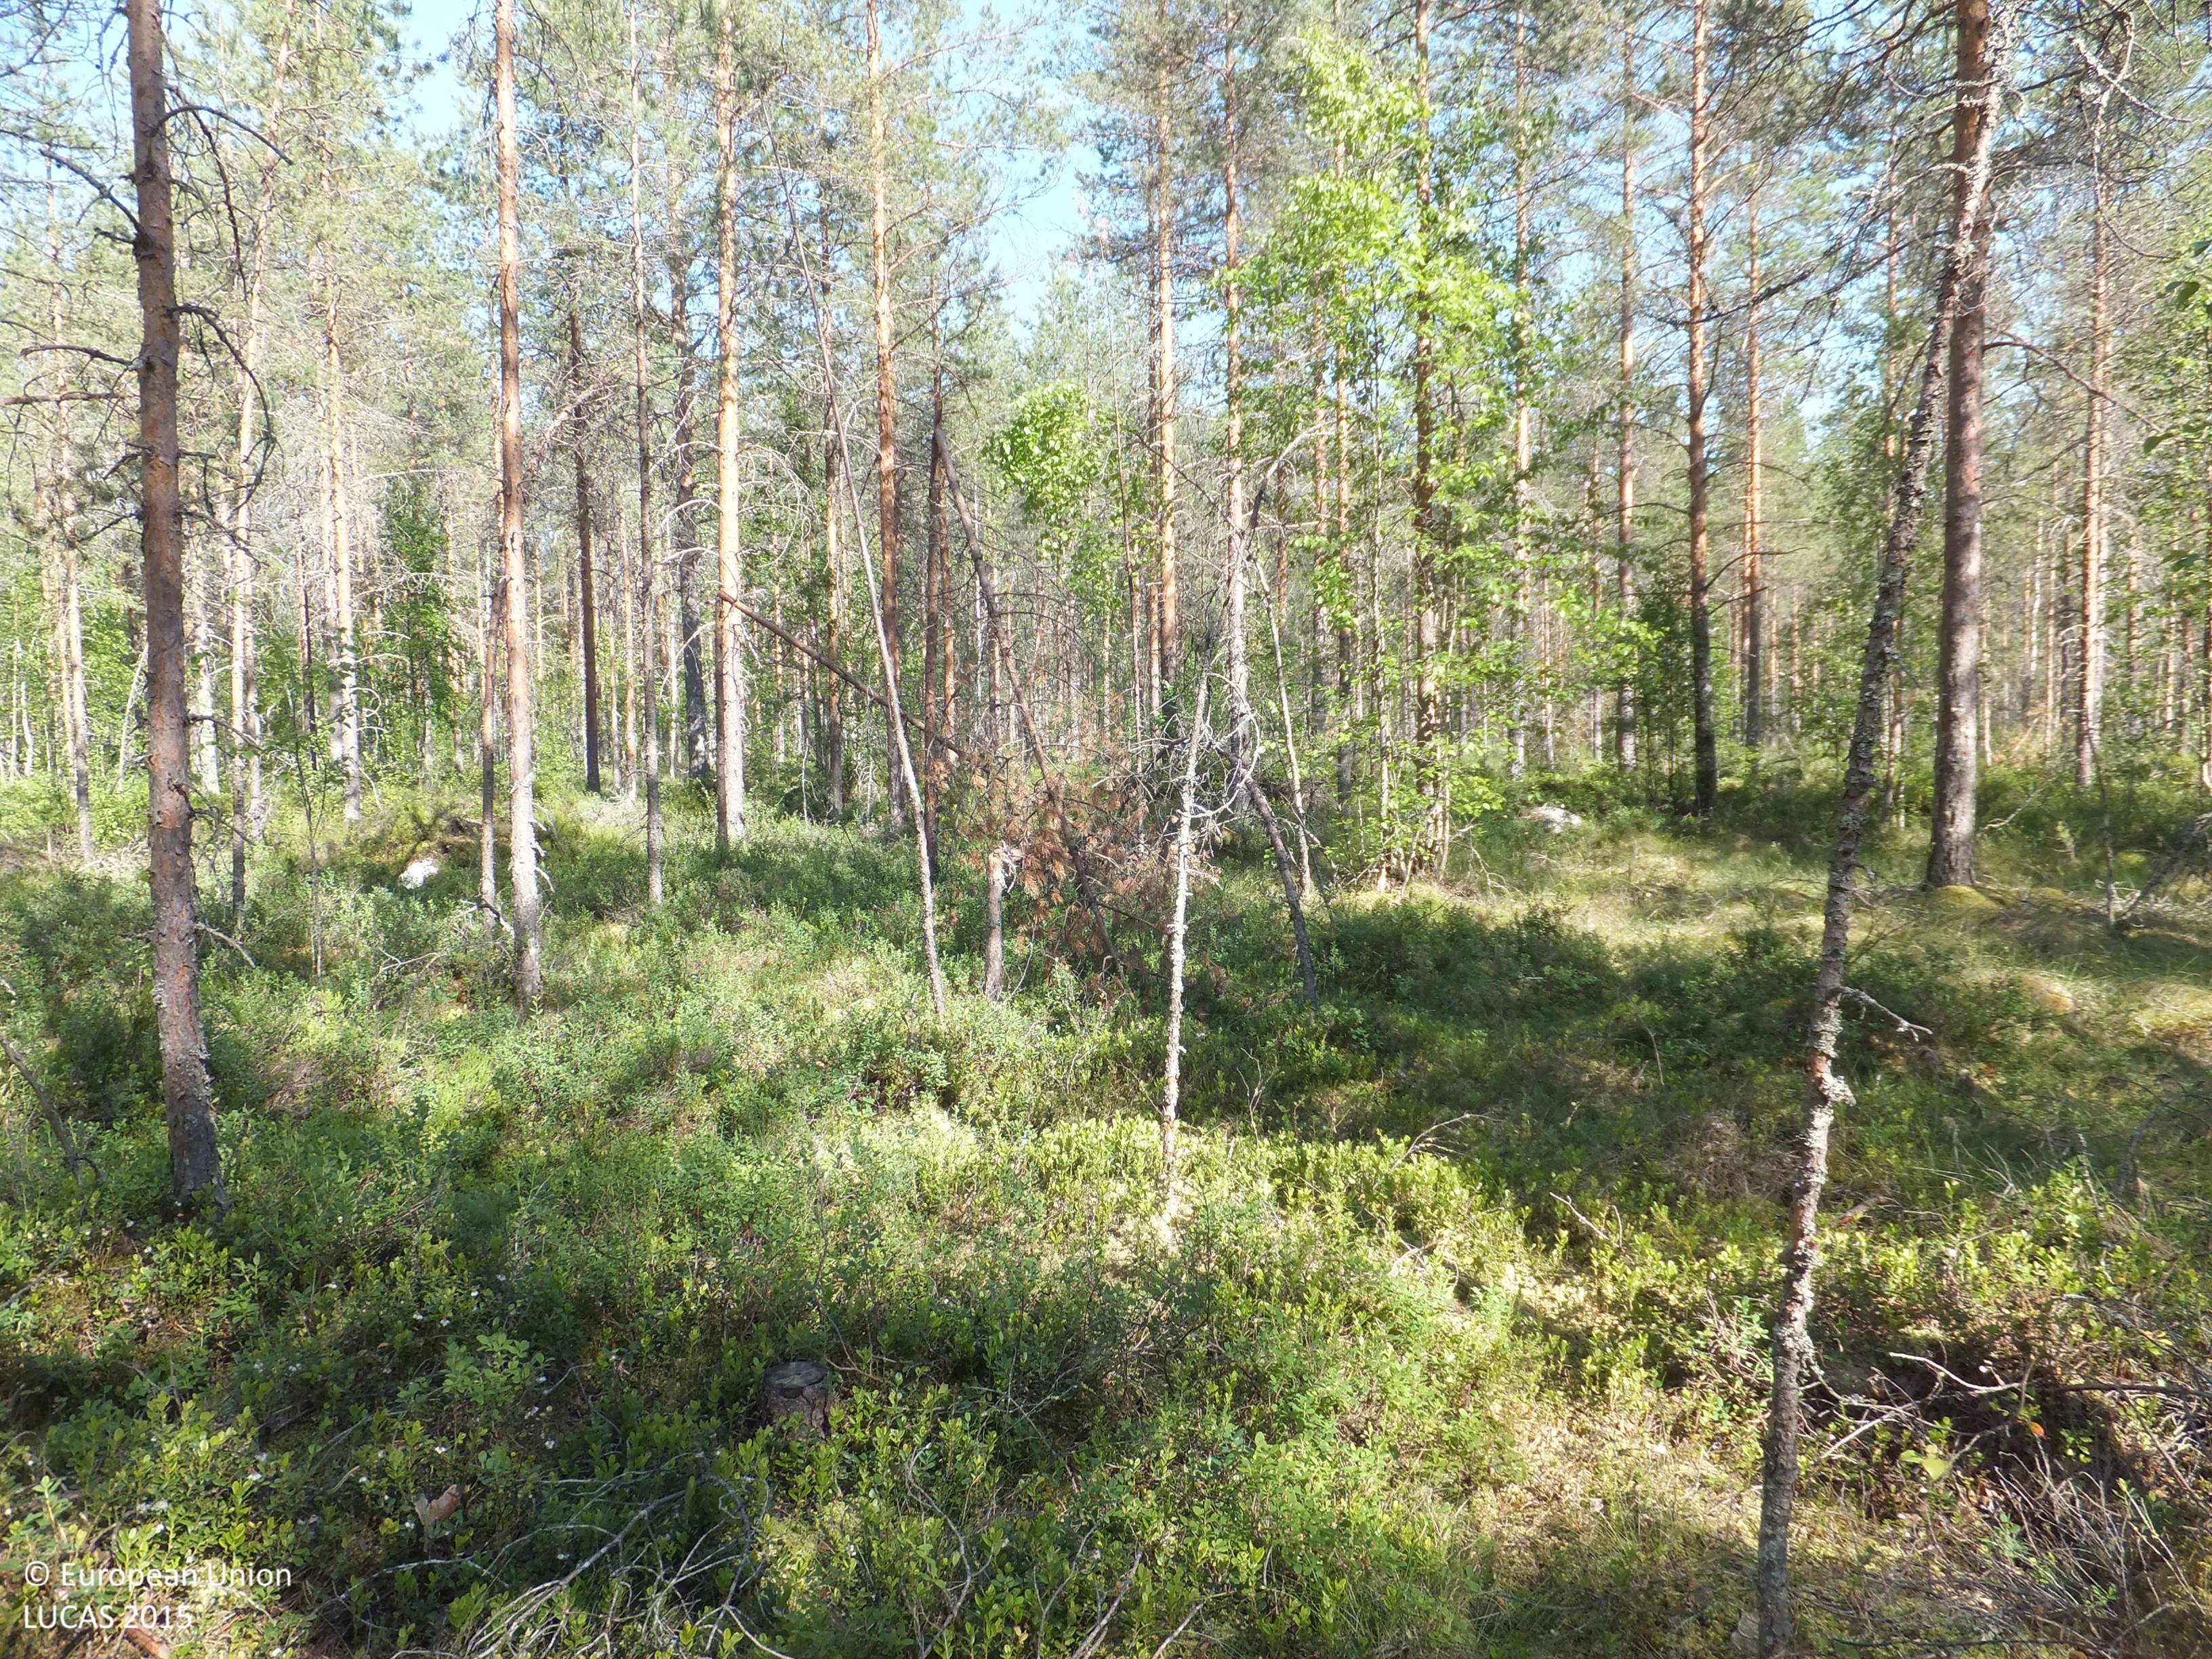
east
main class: Woodland
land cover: Pine dominated mixed woodland
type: boreal forest
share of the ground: 50 - 75 %
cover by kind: coniferous forest trees 45 %, broadleaved forest trees 15 %, shrubs 15 %, lichens and mosses 15 %, herbaceous plants 10 %
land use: Forestry
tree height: > 5 m
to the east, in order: Pine dominated mixed woodland; Ditches and canals; Pine dominated mixed woodland; Ditches and canals; Pine dominated mixed woodland; Pine dominated coniferous woodland; Grass margins; Pine dominated mixed woodland; Ditches and canals; Pine dominated mixed woodland; Ditches and canals; Pine dominated mixed woodland
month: July
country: FI
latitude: 63.0540
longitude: 24.2218
